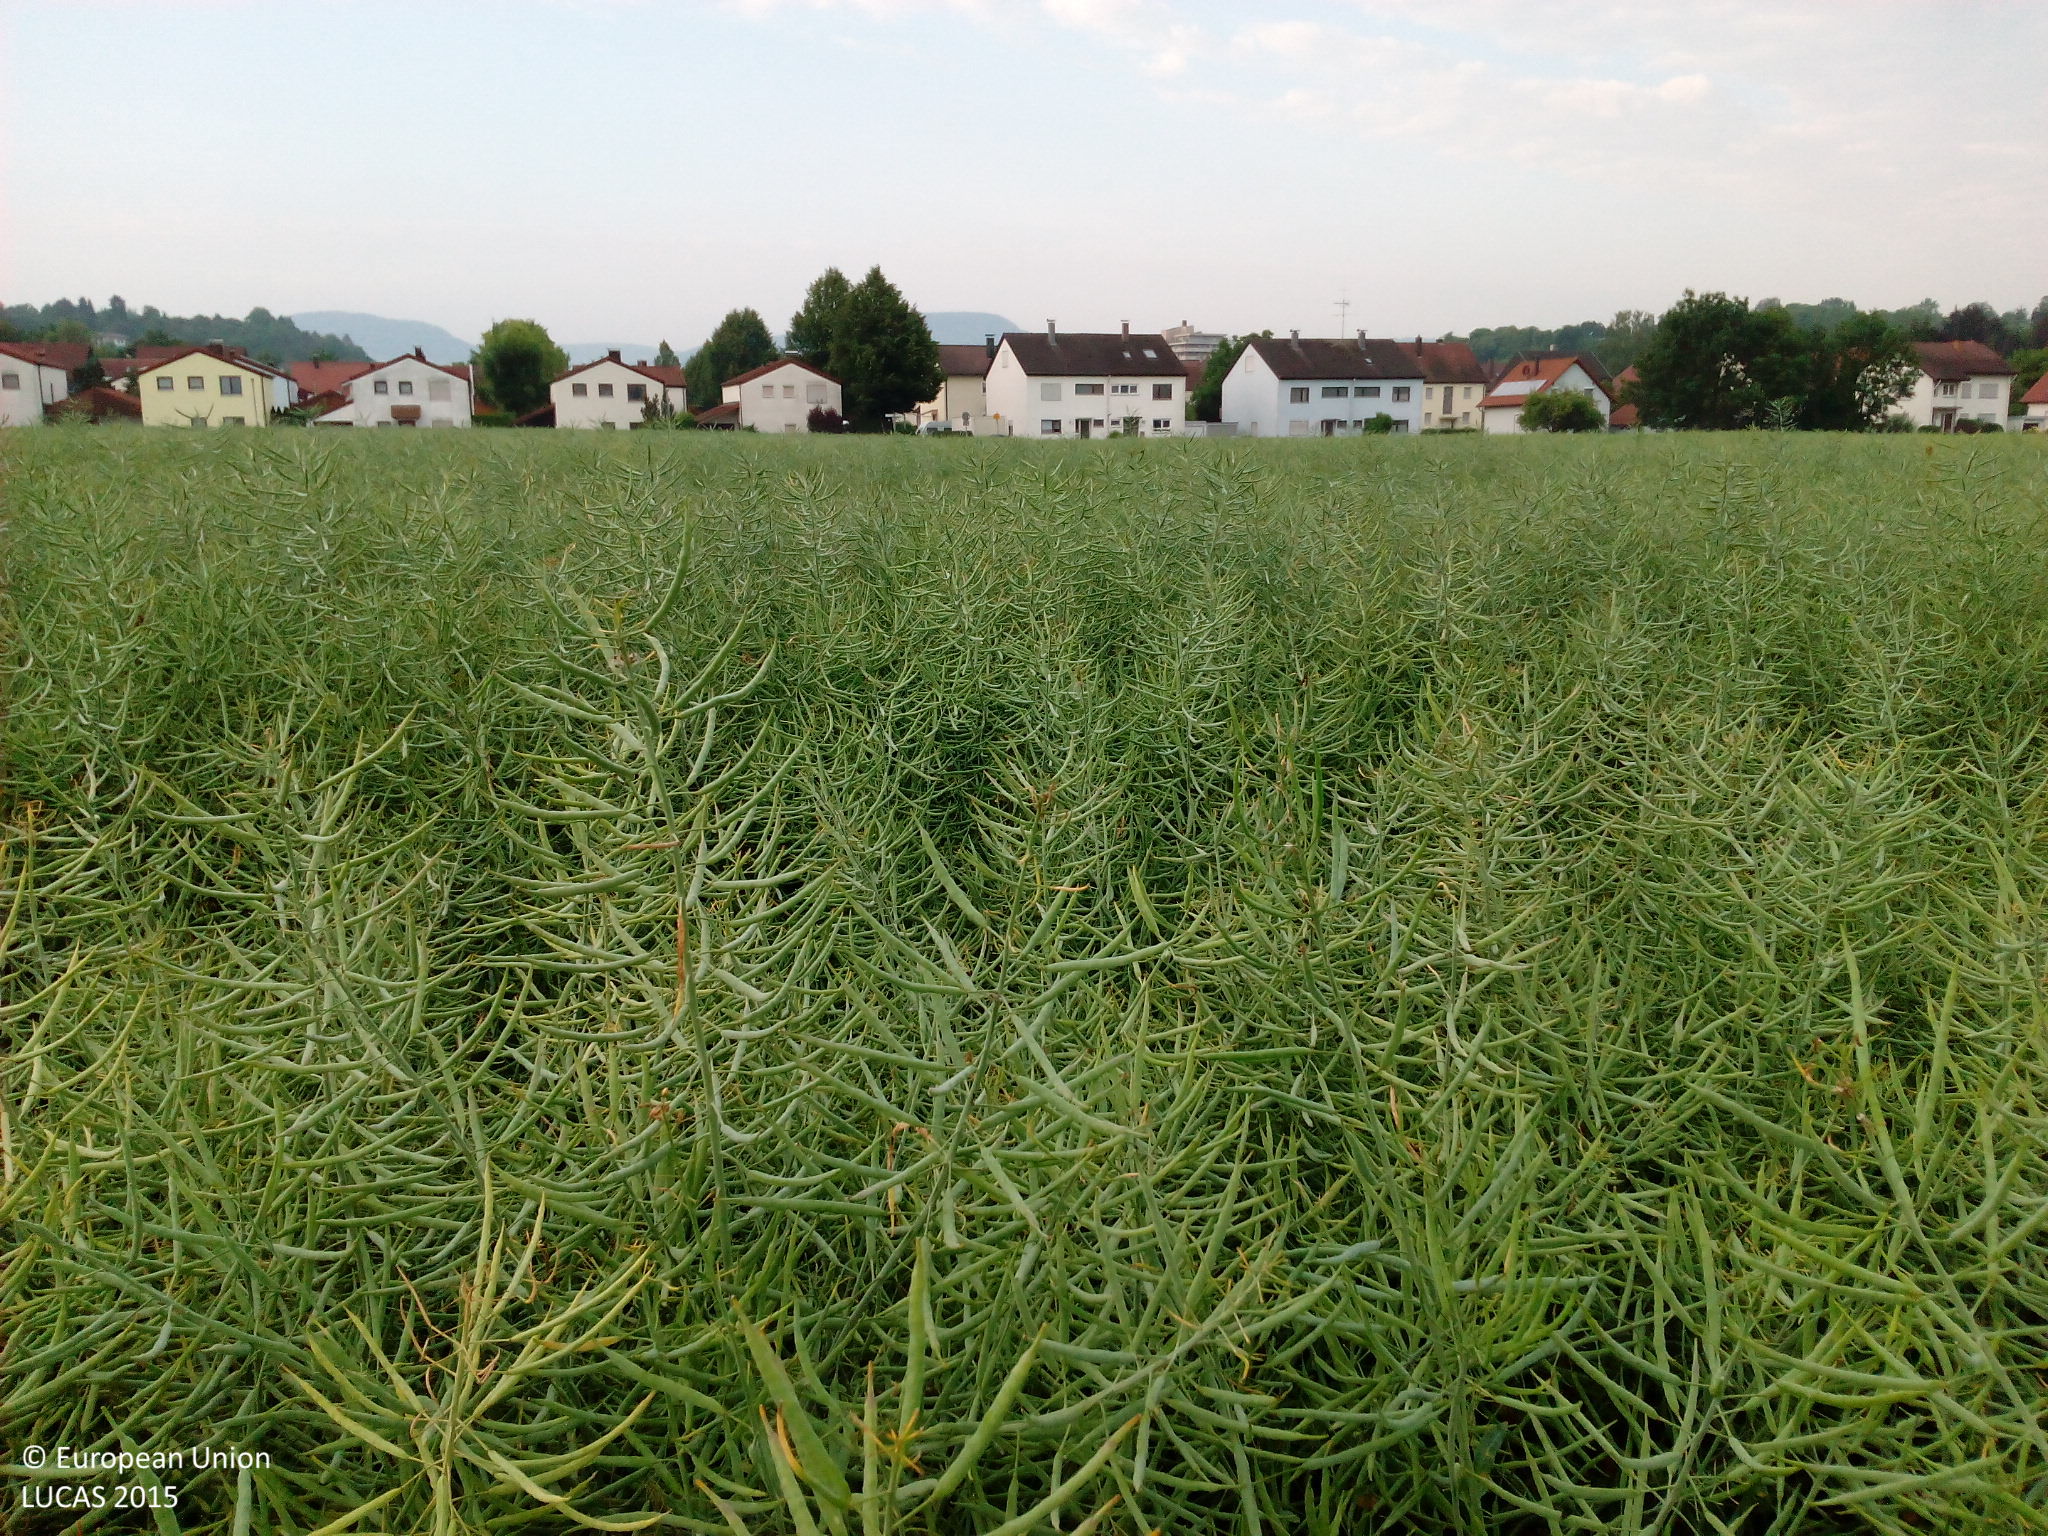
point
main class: Cropland
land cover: Rape and turnip rape
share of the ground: > 75 %
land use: Agriculture (excluding fallow land and kitchen gardens)
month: June
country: DE
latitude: 48.6909
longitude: 9.6877
